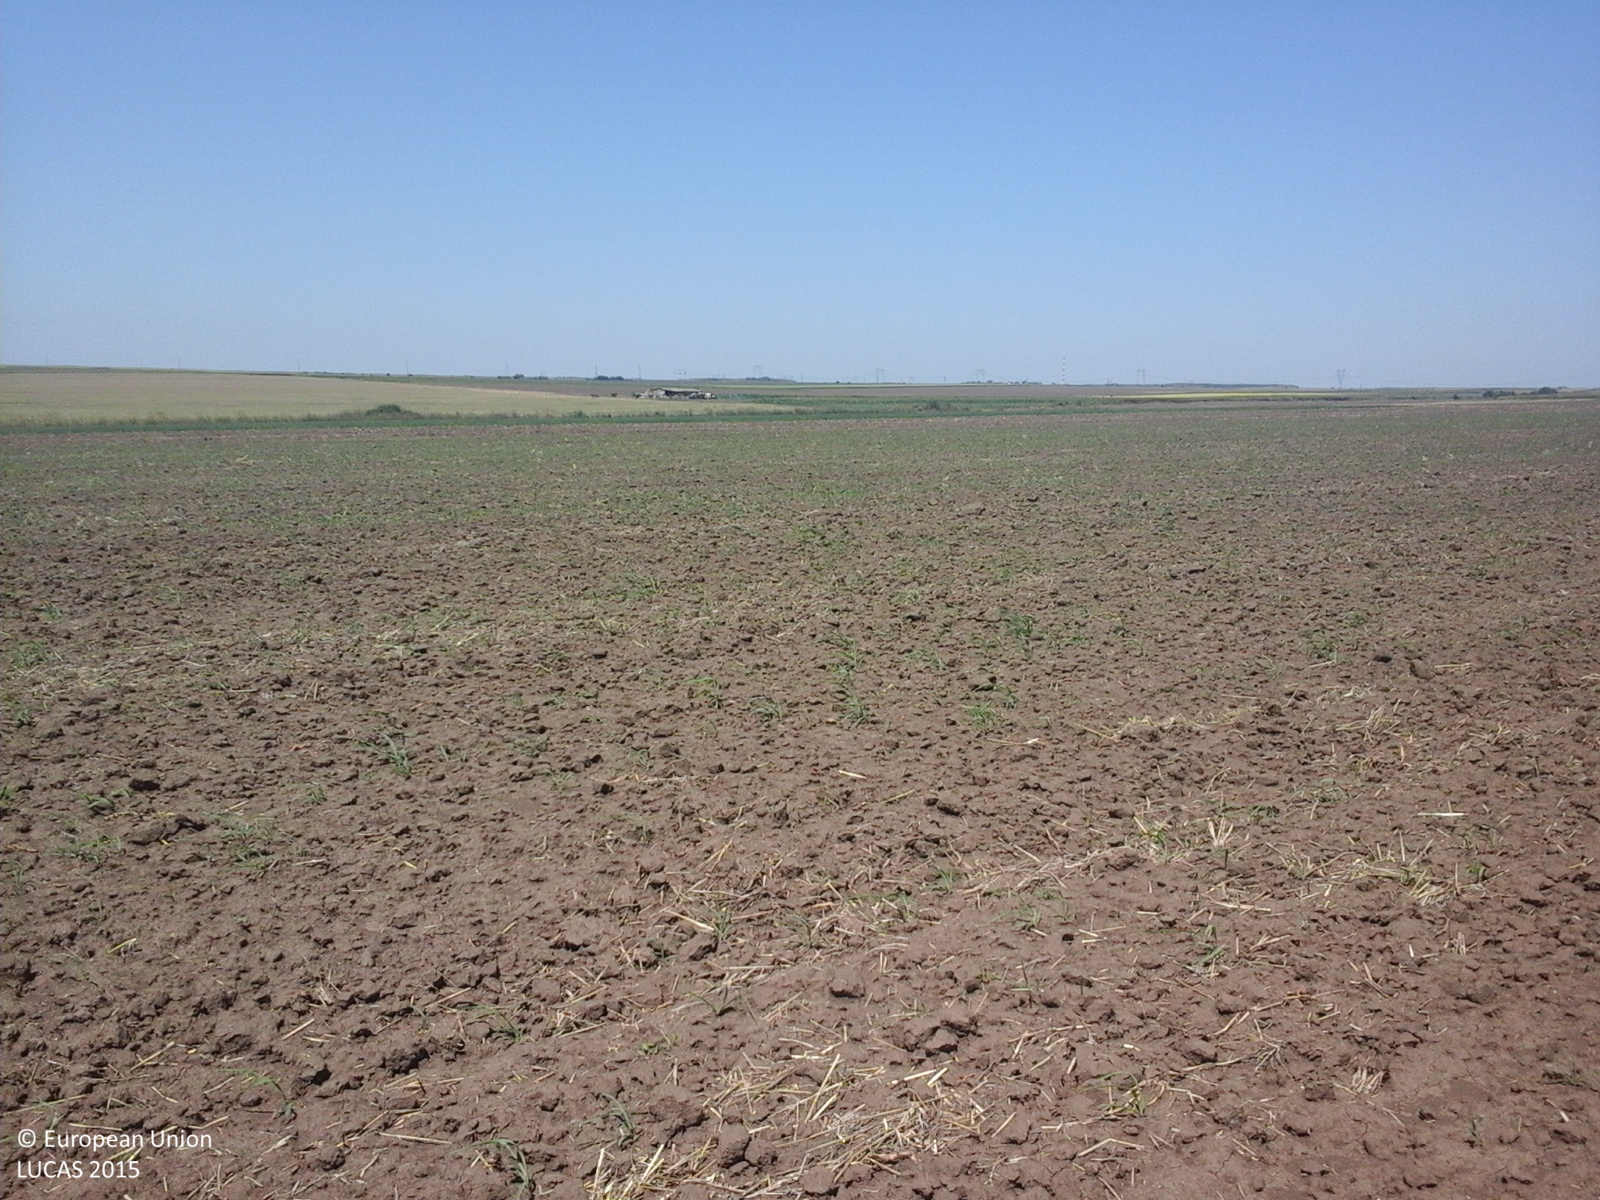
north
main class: Cropland
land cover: Common wheat
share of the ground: < 10 %
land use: Agriculture (excluding fallow land and kitchen gardens)
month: August
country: RO
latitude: 44.2364
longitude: 28.5138
